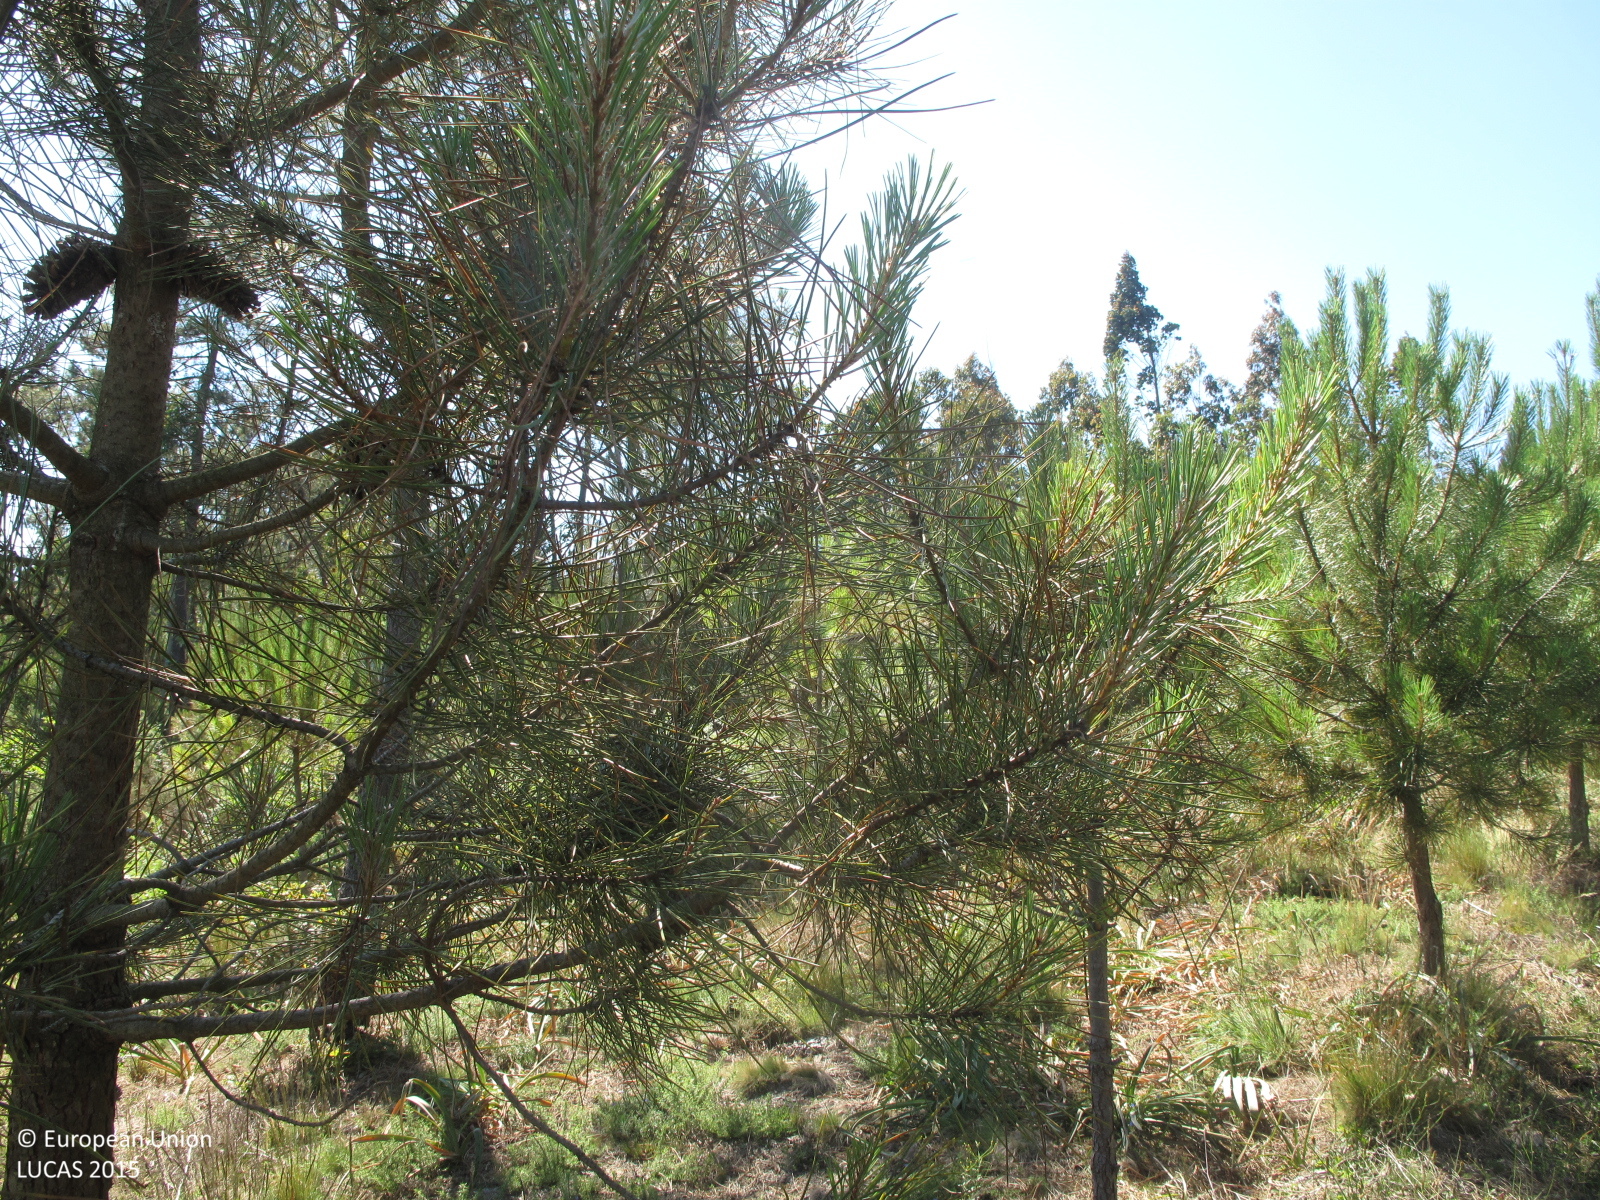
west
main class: Woodland
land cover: Pine dominated coniferous woodland
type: coniferous forest of the mediterranean region
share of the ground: 25 - 50 %
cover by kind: coniferous forest trees 40 %, herbaceous plants 30 %, shrubs 20 %, broadleaved forest trees 10 %
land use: Forestry
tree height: < 5 m
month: June
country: ES
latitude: 43.0414
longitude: -8.6834
